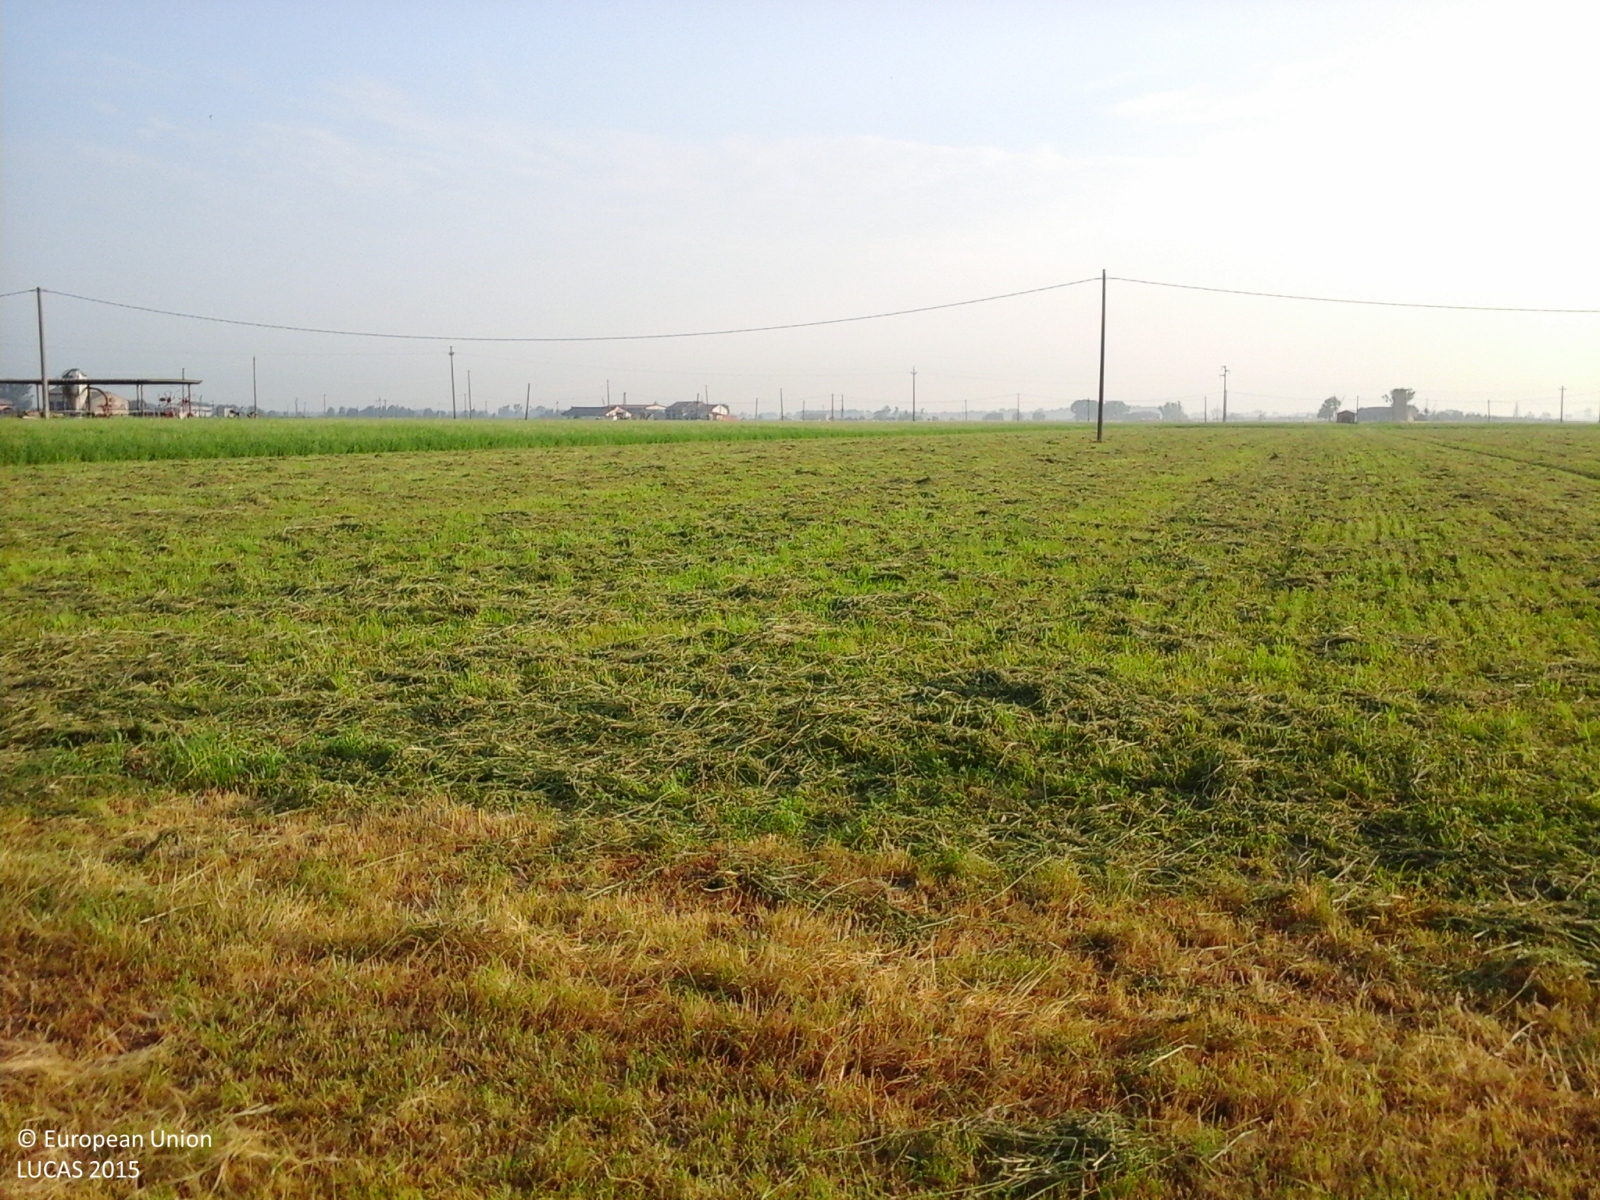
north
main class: Cropland
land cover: Lucerne
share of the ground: > 75 %
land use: Agriculture (excluding fallow land and kitchen gardens)
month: June
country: IT
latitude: 44.9635
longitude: 10.1645
